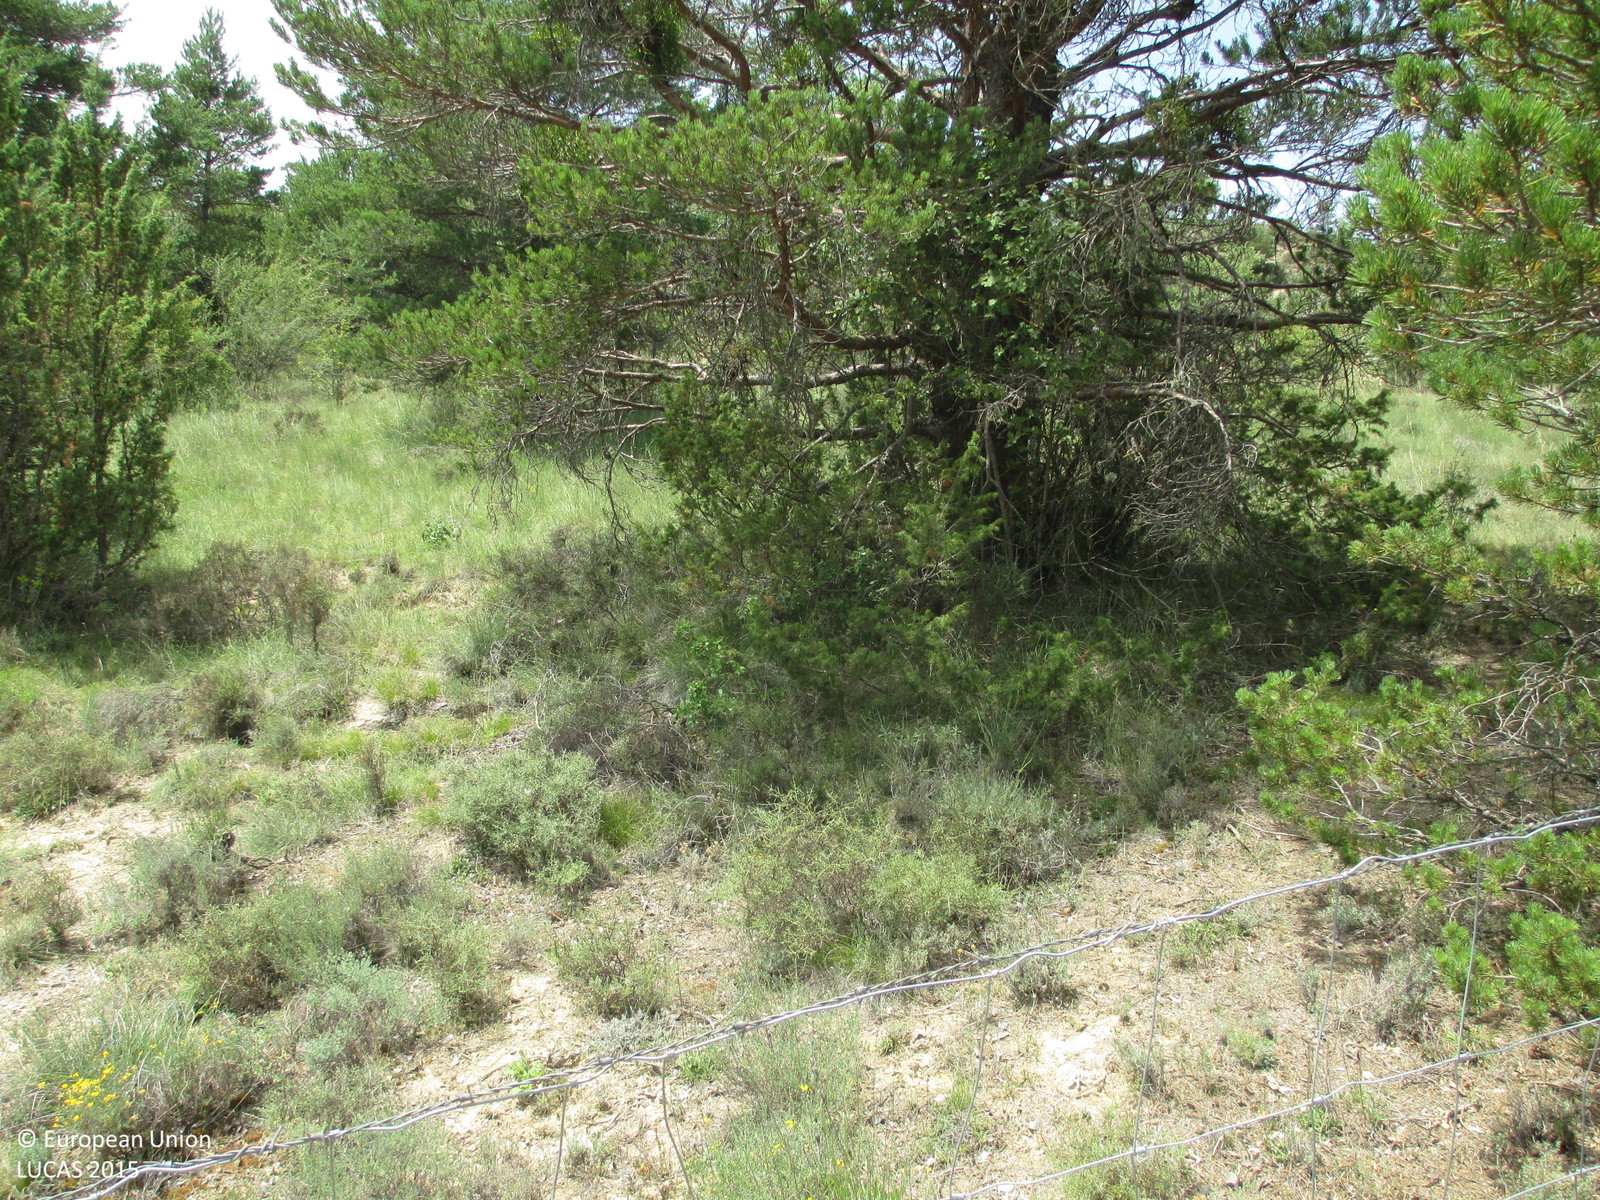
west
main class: Grassland
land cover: Grassland with sparse tree/shrub cover
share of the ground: > 75 %
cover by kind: herbaceous plants 85 %, coniferous forest trees 5 %, shrubs 5 %, unconsolidated bare surface 5 %
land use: Semi-natural and natural areas not in use
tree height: < 5 m
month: July
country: ES
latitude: 42.4248
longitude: -0.4166
